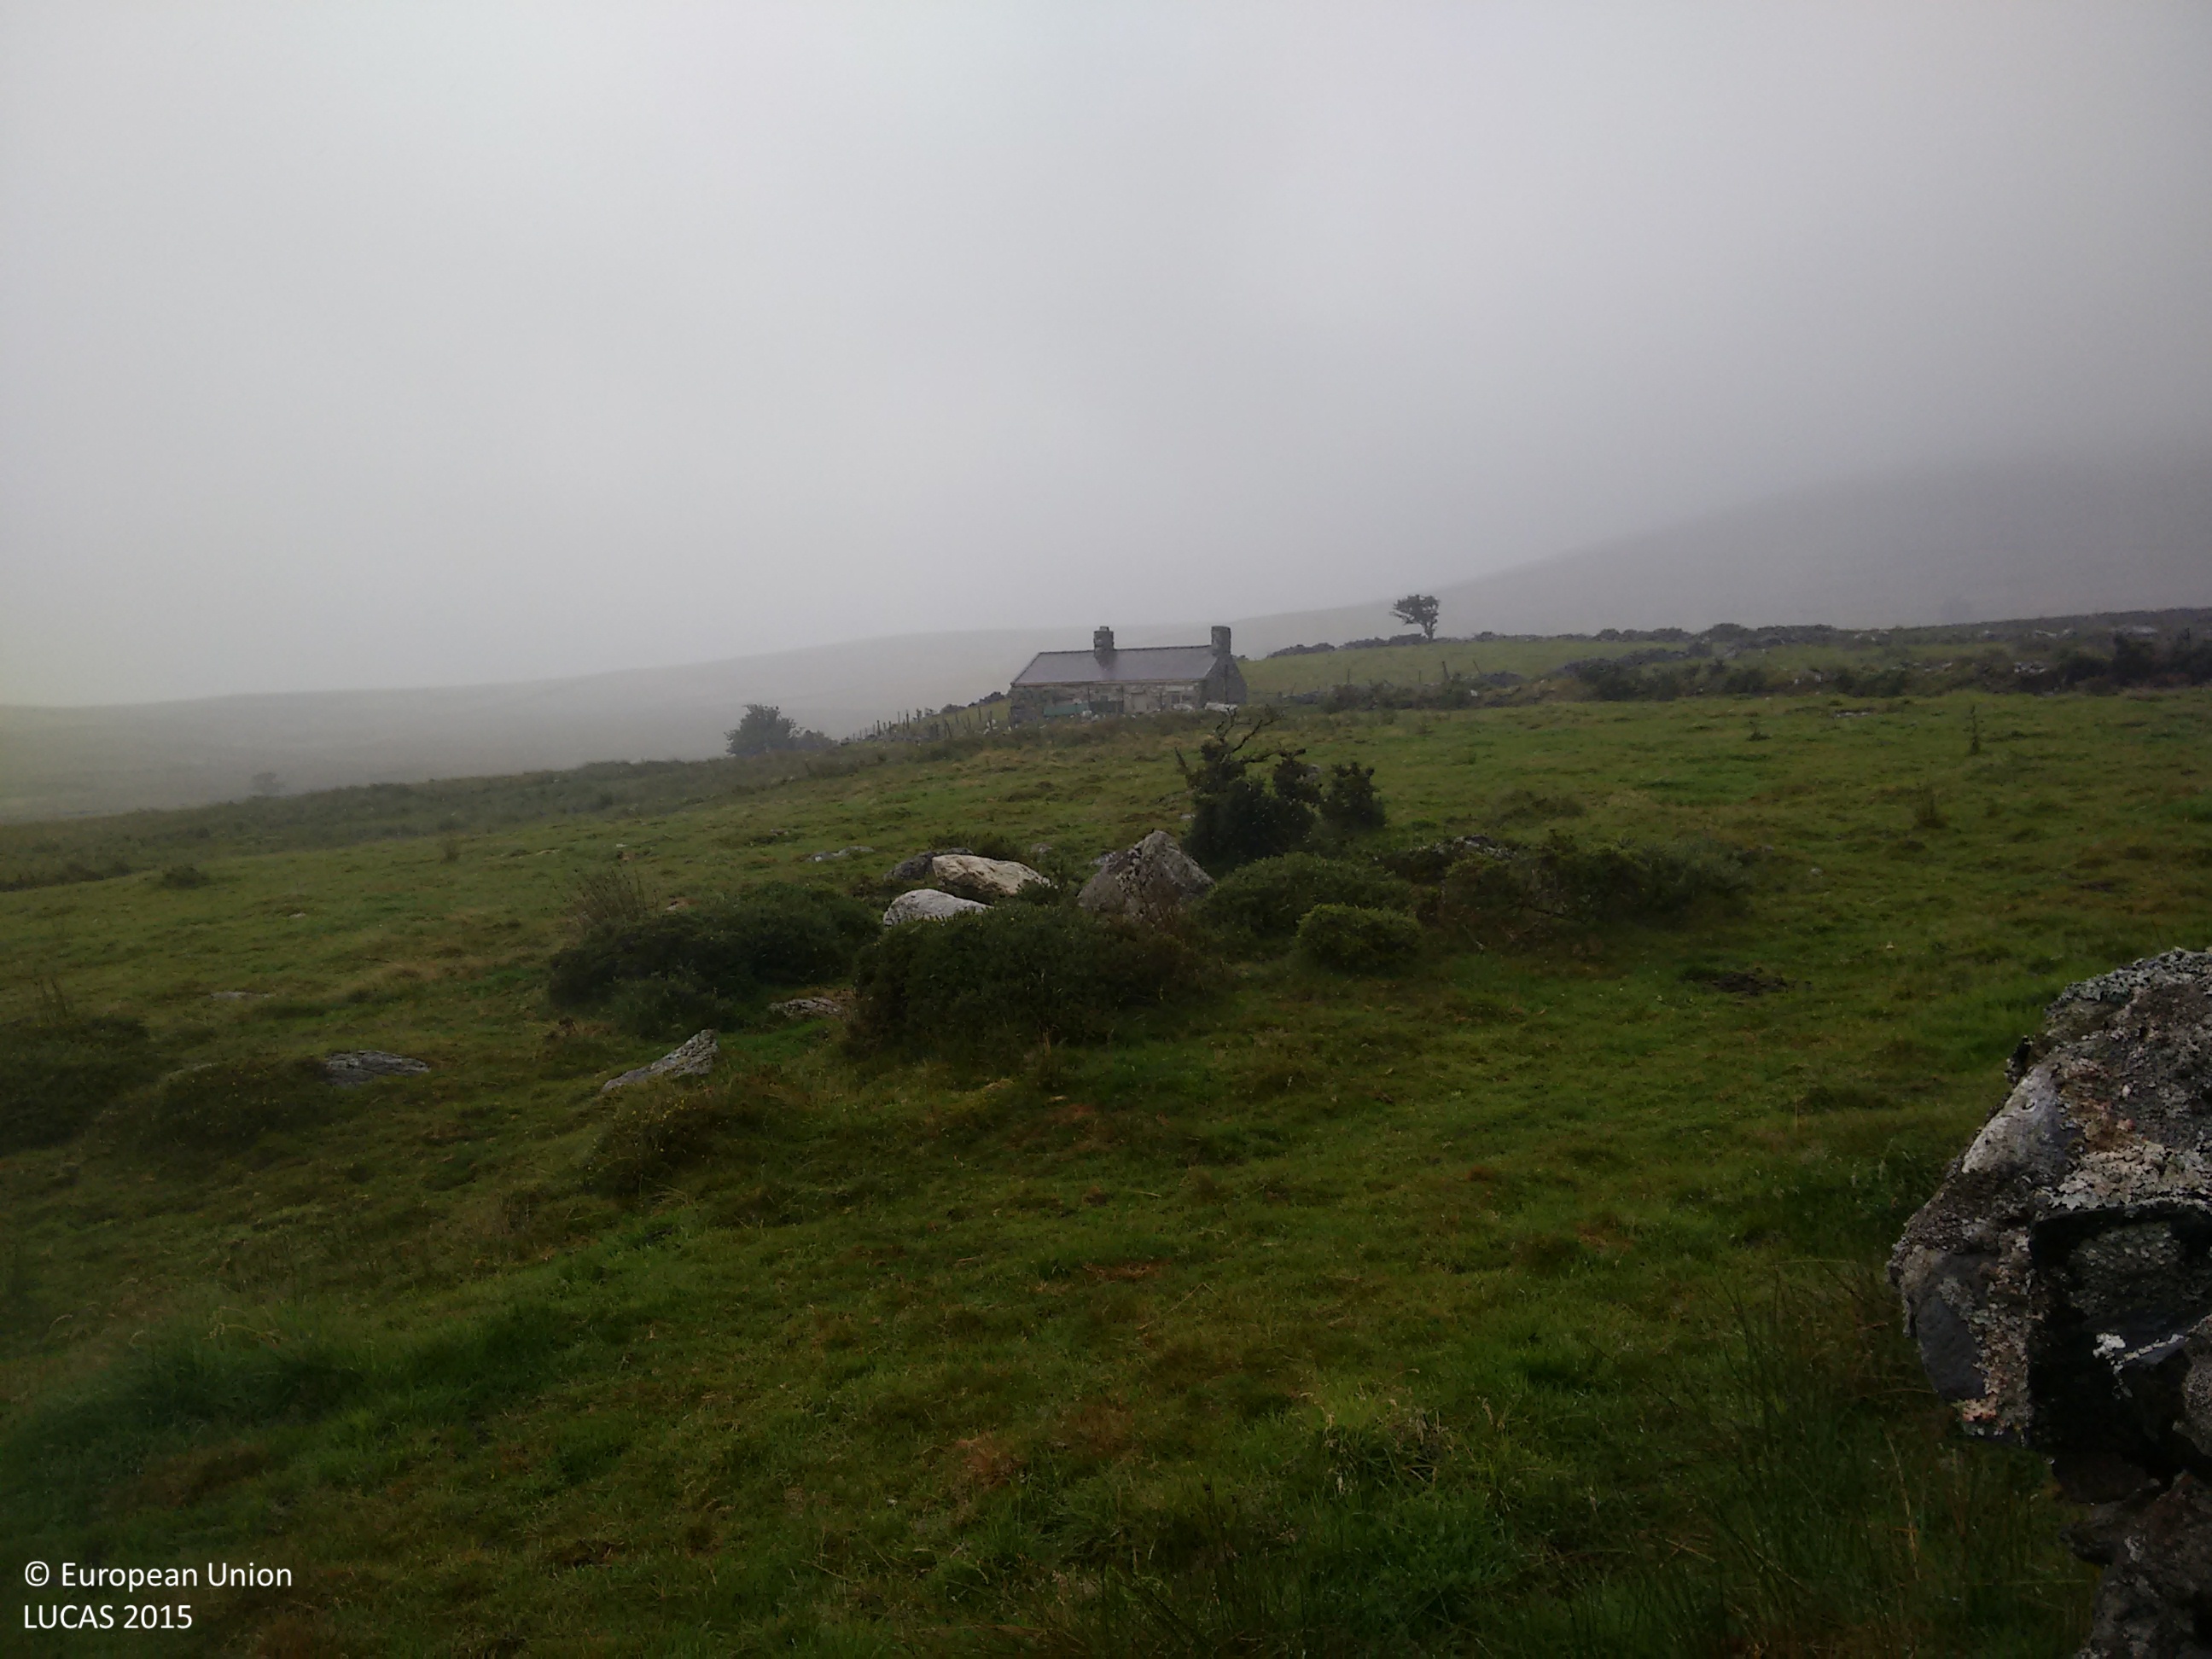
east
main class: Grassland
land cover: Grassland without tree/shrub cover
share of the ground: > 75 %
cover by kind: herbaceous plants 100 %
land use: Agriculture (excluding fallow land and kitchen gardens)
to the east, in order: Grassland without tree/shrub cover; Shruby margins; Dry stone walls; Tracks; Dry stone walls; Grassland without tree/shrub cover; Dry stone walls; Grassland without tree/shrub cover; Dry stone walls; Grassland without tree/shrub cover
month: August
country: GB
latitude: 53.0284
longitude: -4.2495
